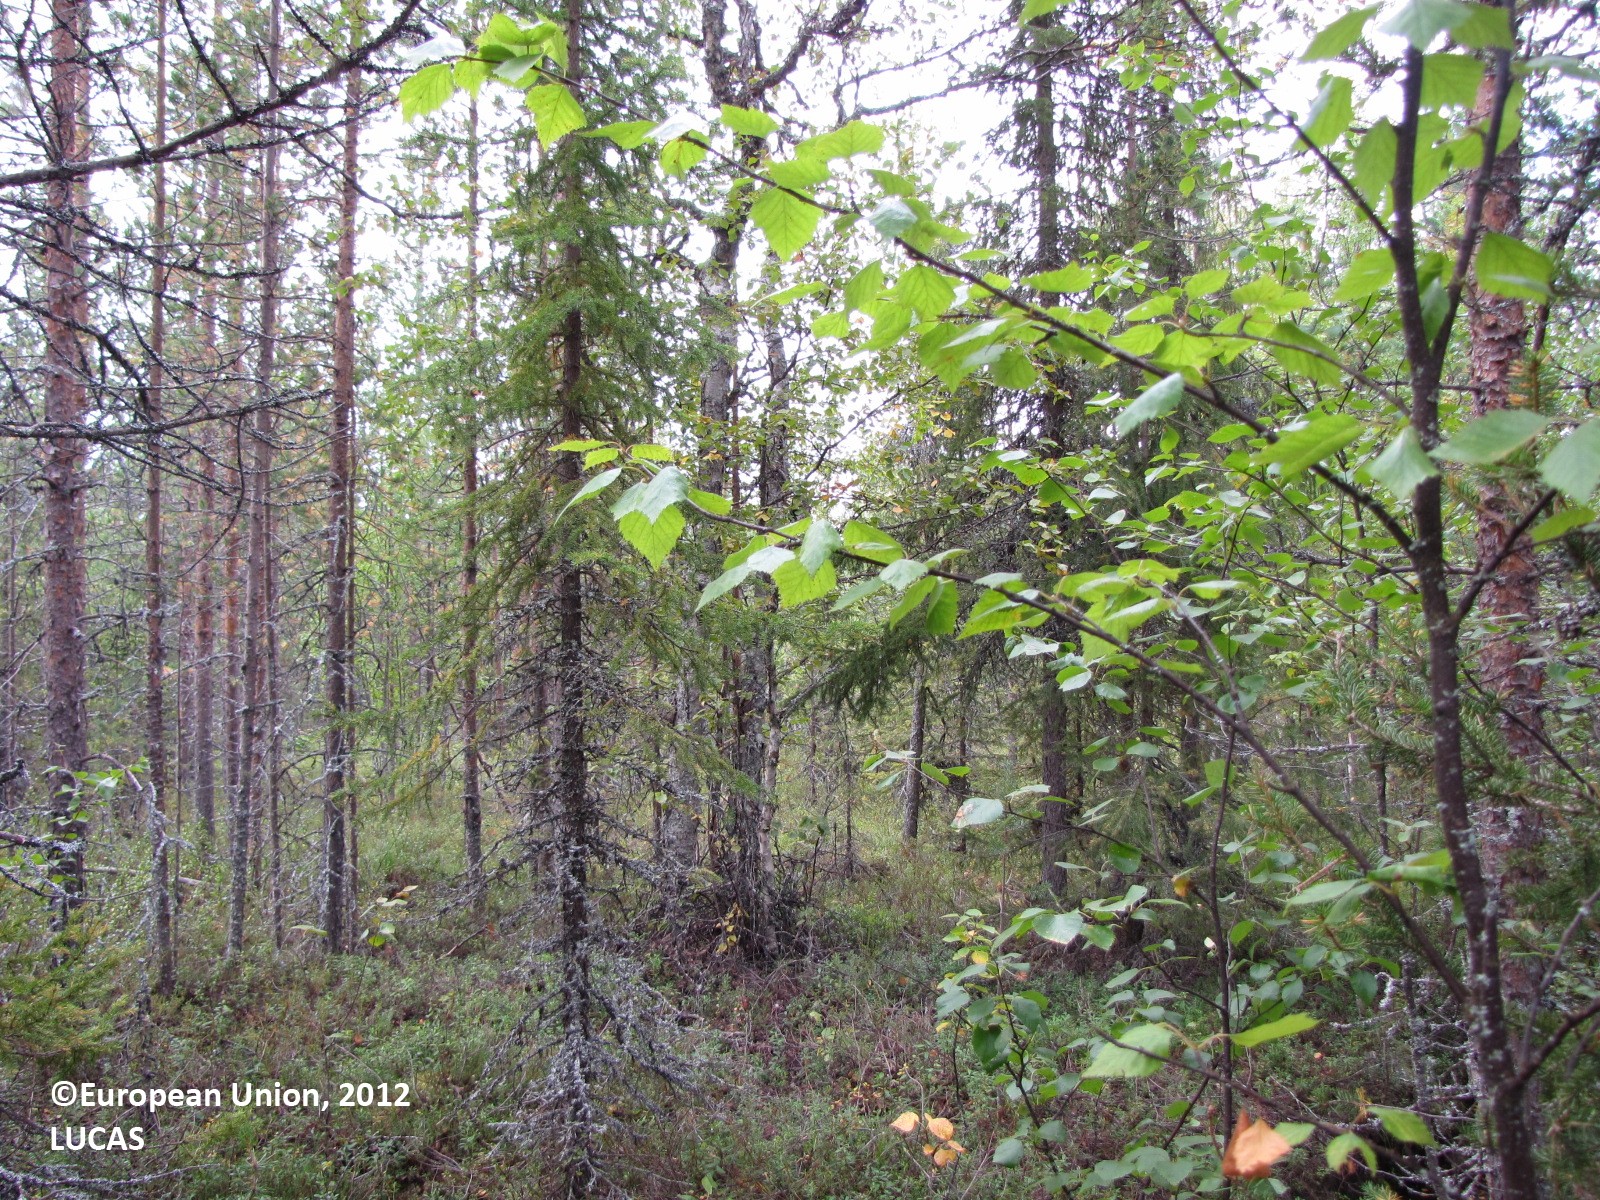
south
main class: Woodland
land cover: Pine dominated mixed woodland
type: boreal forest
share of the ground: > 75 %
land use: Forestry
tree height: > 5 m
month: August
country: FI
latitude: 67.1322
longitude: 25.0579
